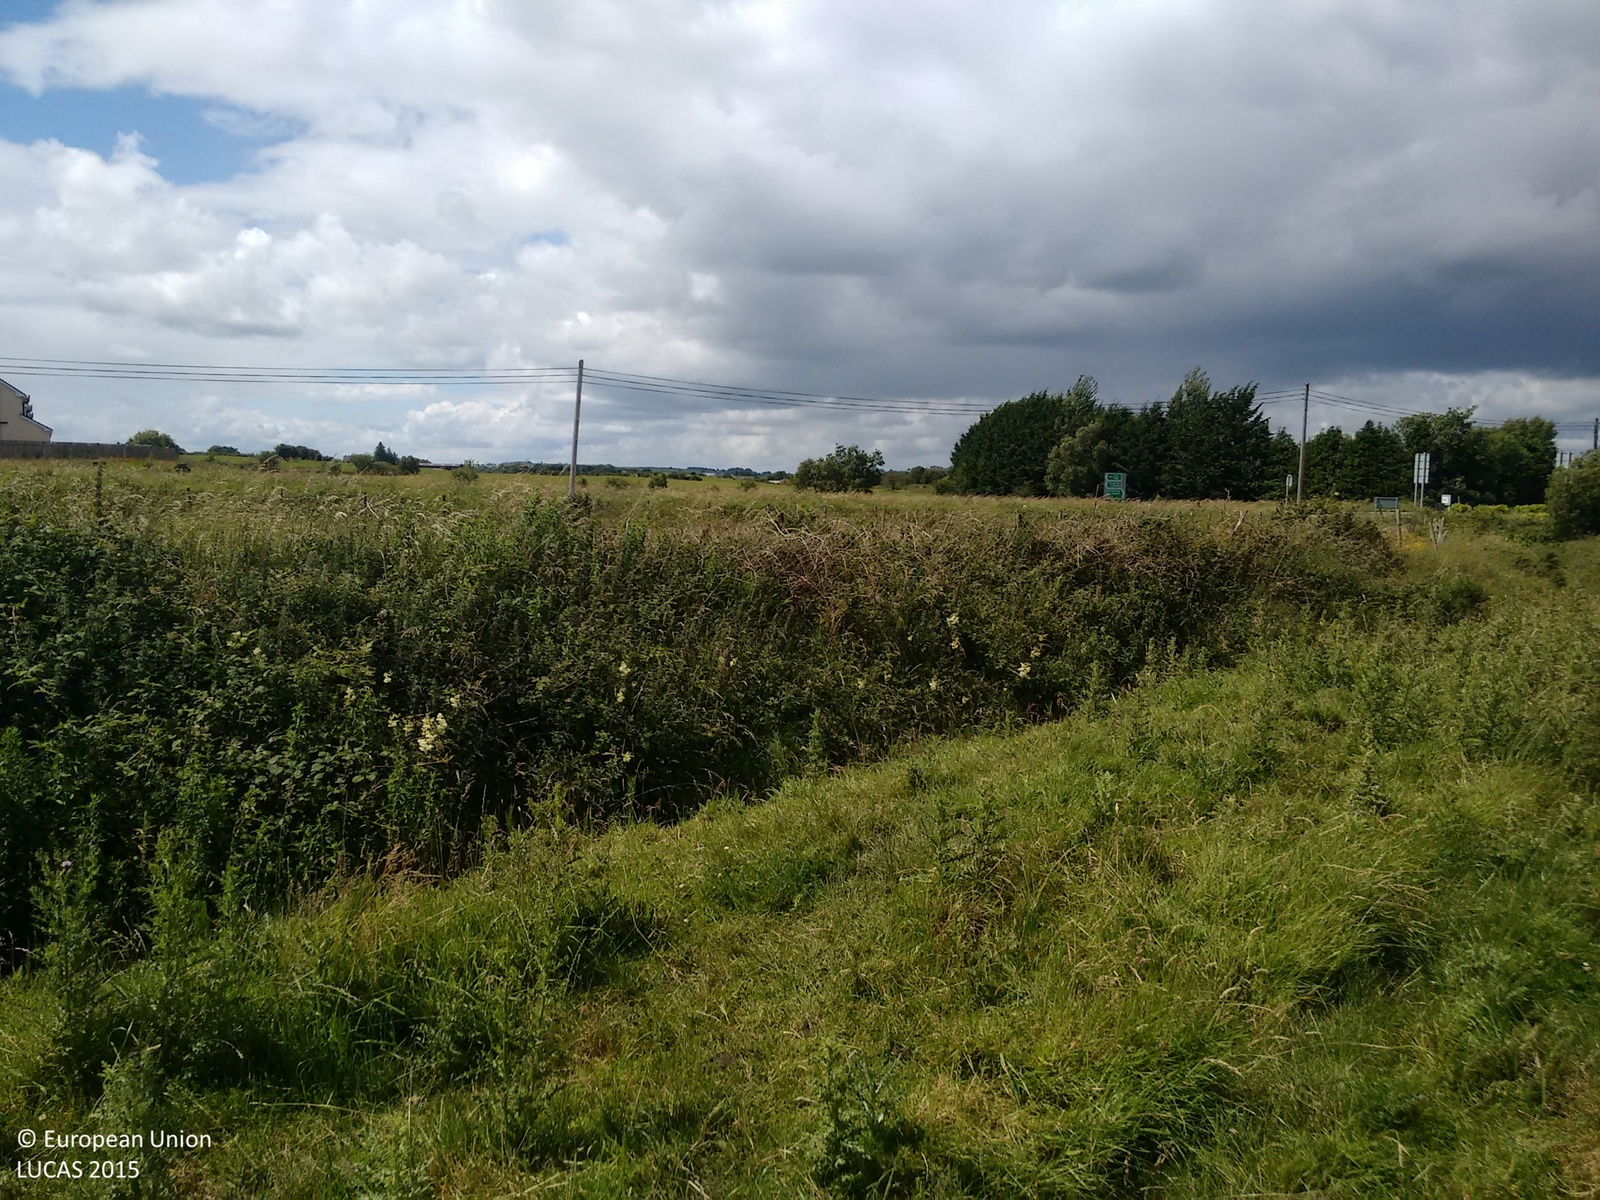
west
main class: Grassland
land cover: Grassland with sparse tree/shrub cover
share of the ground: 50 - 75 %
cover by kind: herbaceous plants 85 %, shrubs 10 %, broadleaved forest trees 5 %
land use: Agriculture (excluding fallow land and kitchen gardens)
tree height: < 5 m
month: July
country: IE
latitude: 53.6925
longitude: -8.7541
